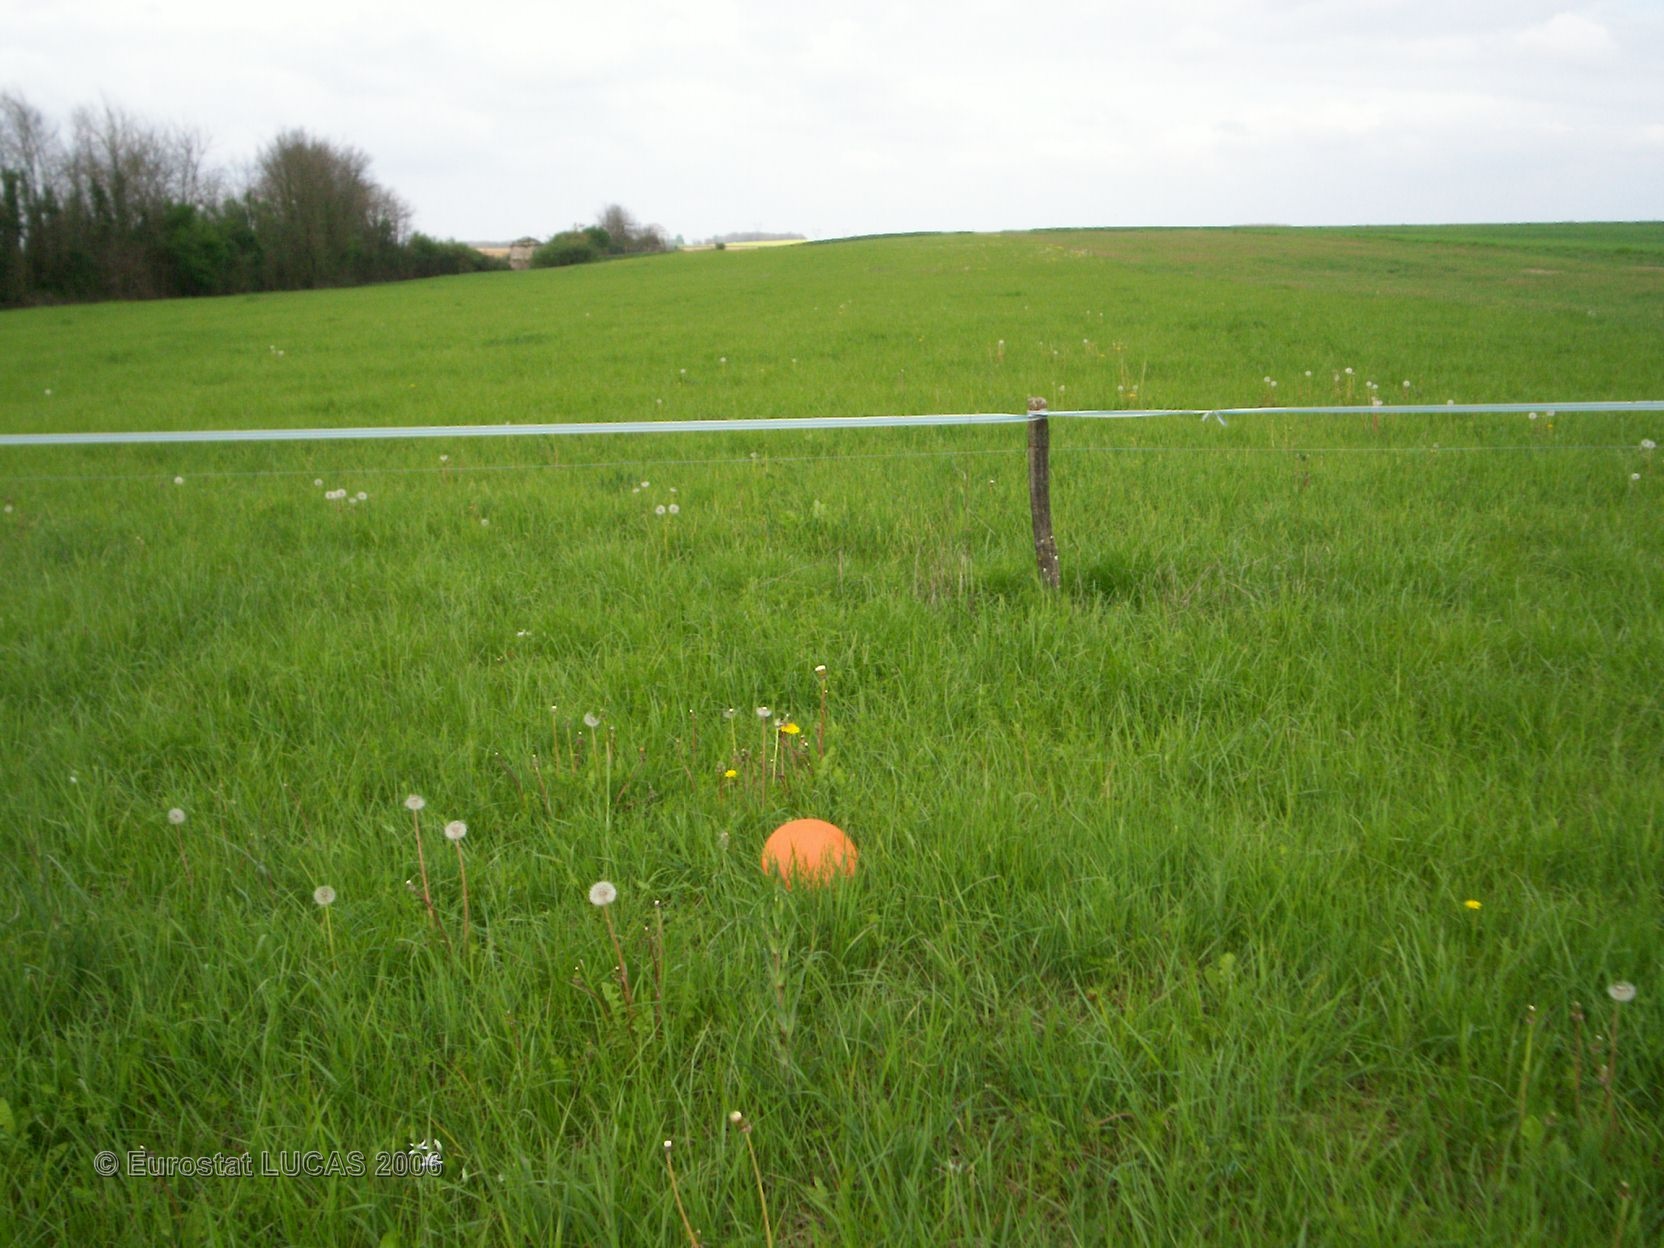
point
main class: Grassland
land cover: Grassland without tree/shrub cover
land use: Agriculture (excluding fallow land and kitchen gardens)
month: April
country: FR
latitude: 46.9985
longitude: 0.3131
